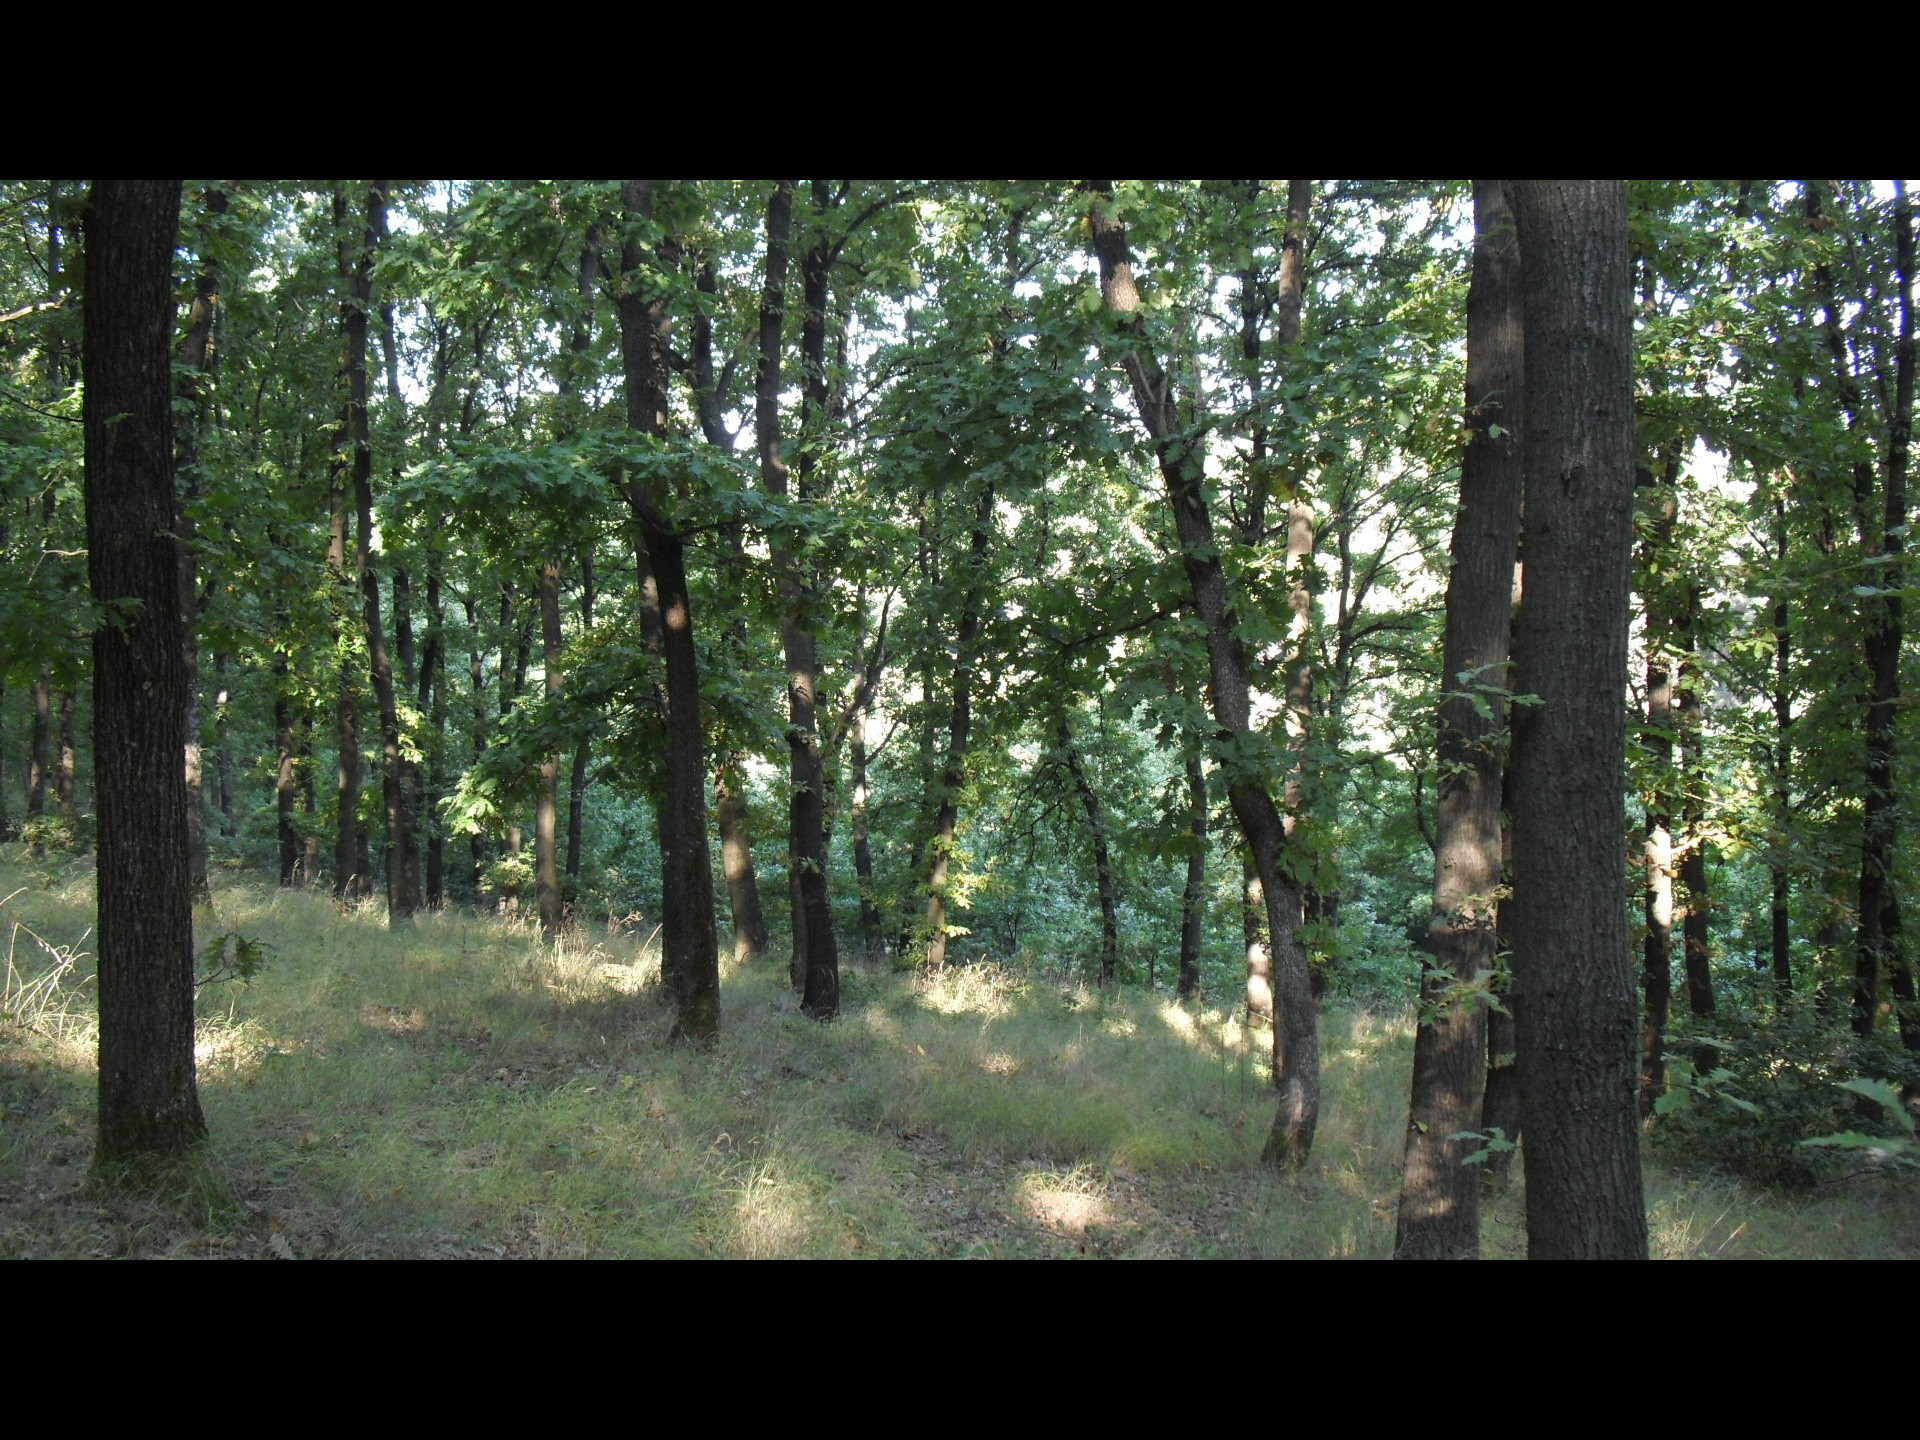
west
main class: Woodland
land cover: Broadleaved woodland
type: mesophytic deciduous forest
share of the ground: > 75 %
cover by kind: broadleaved forest trees 85 %, herbaceous plants 15 %
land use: Forestry
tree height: > 5 m
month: September
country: BG
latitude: 44.0496
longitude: 22.6302
